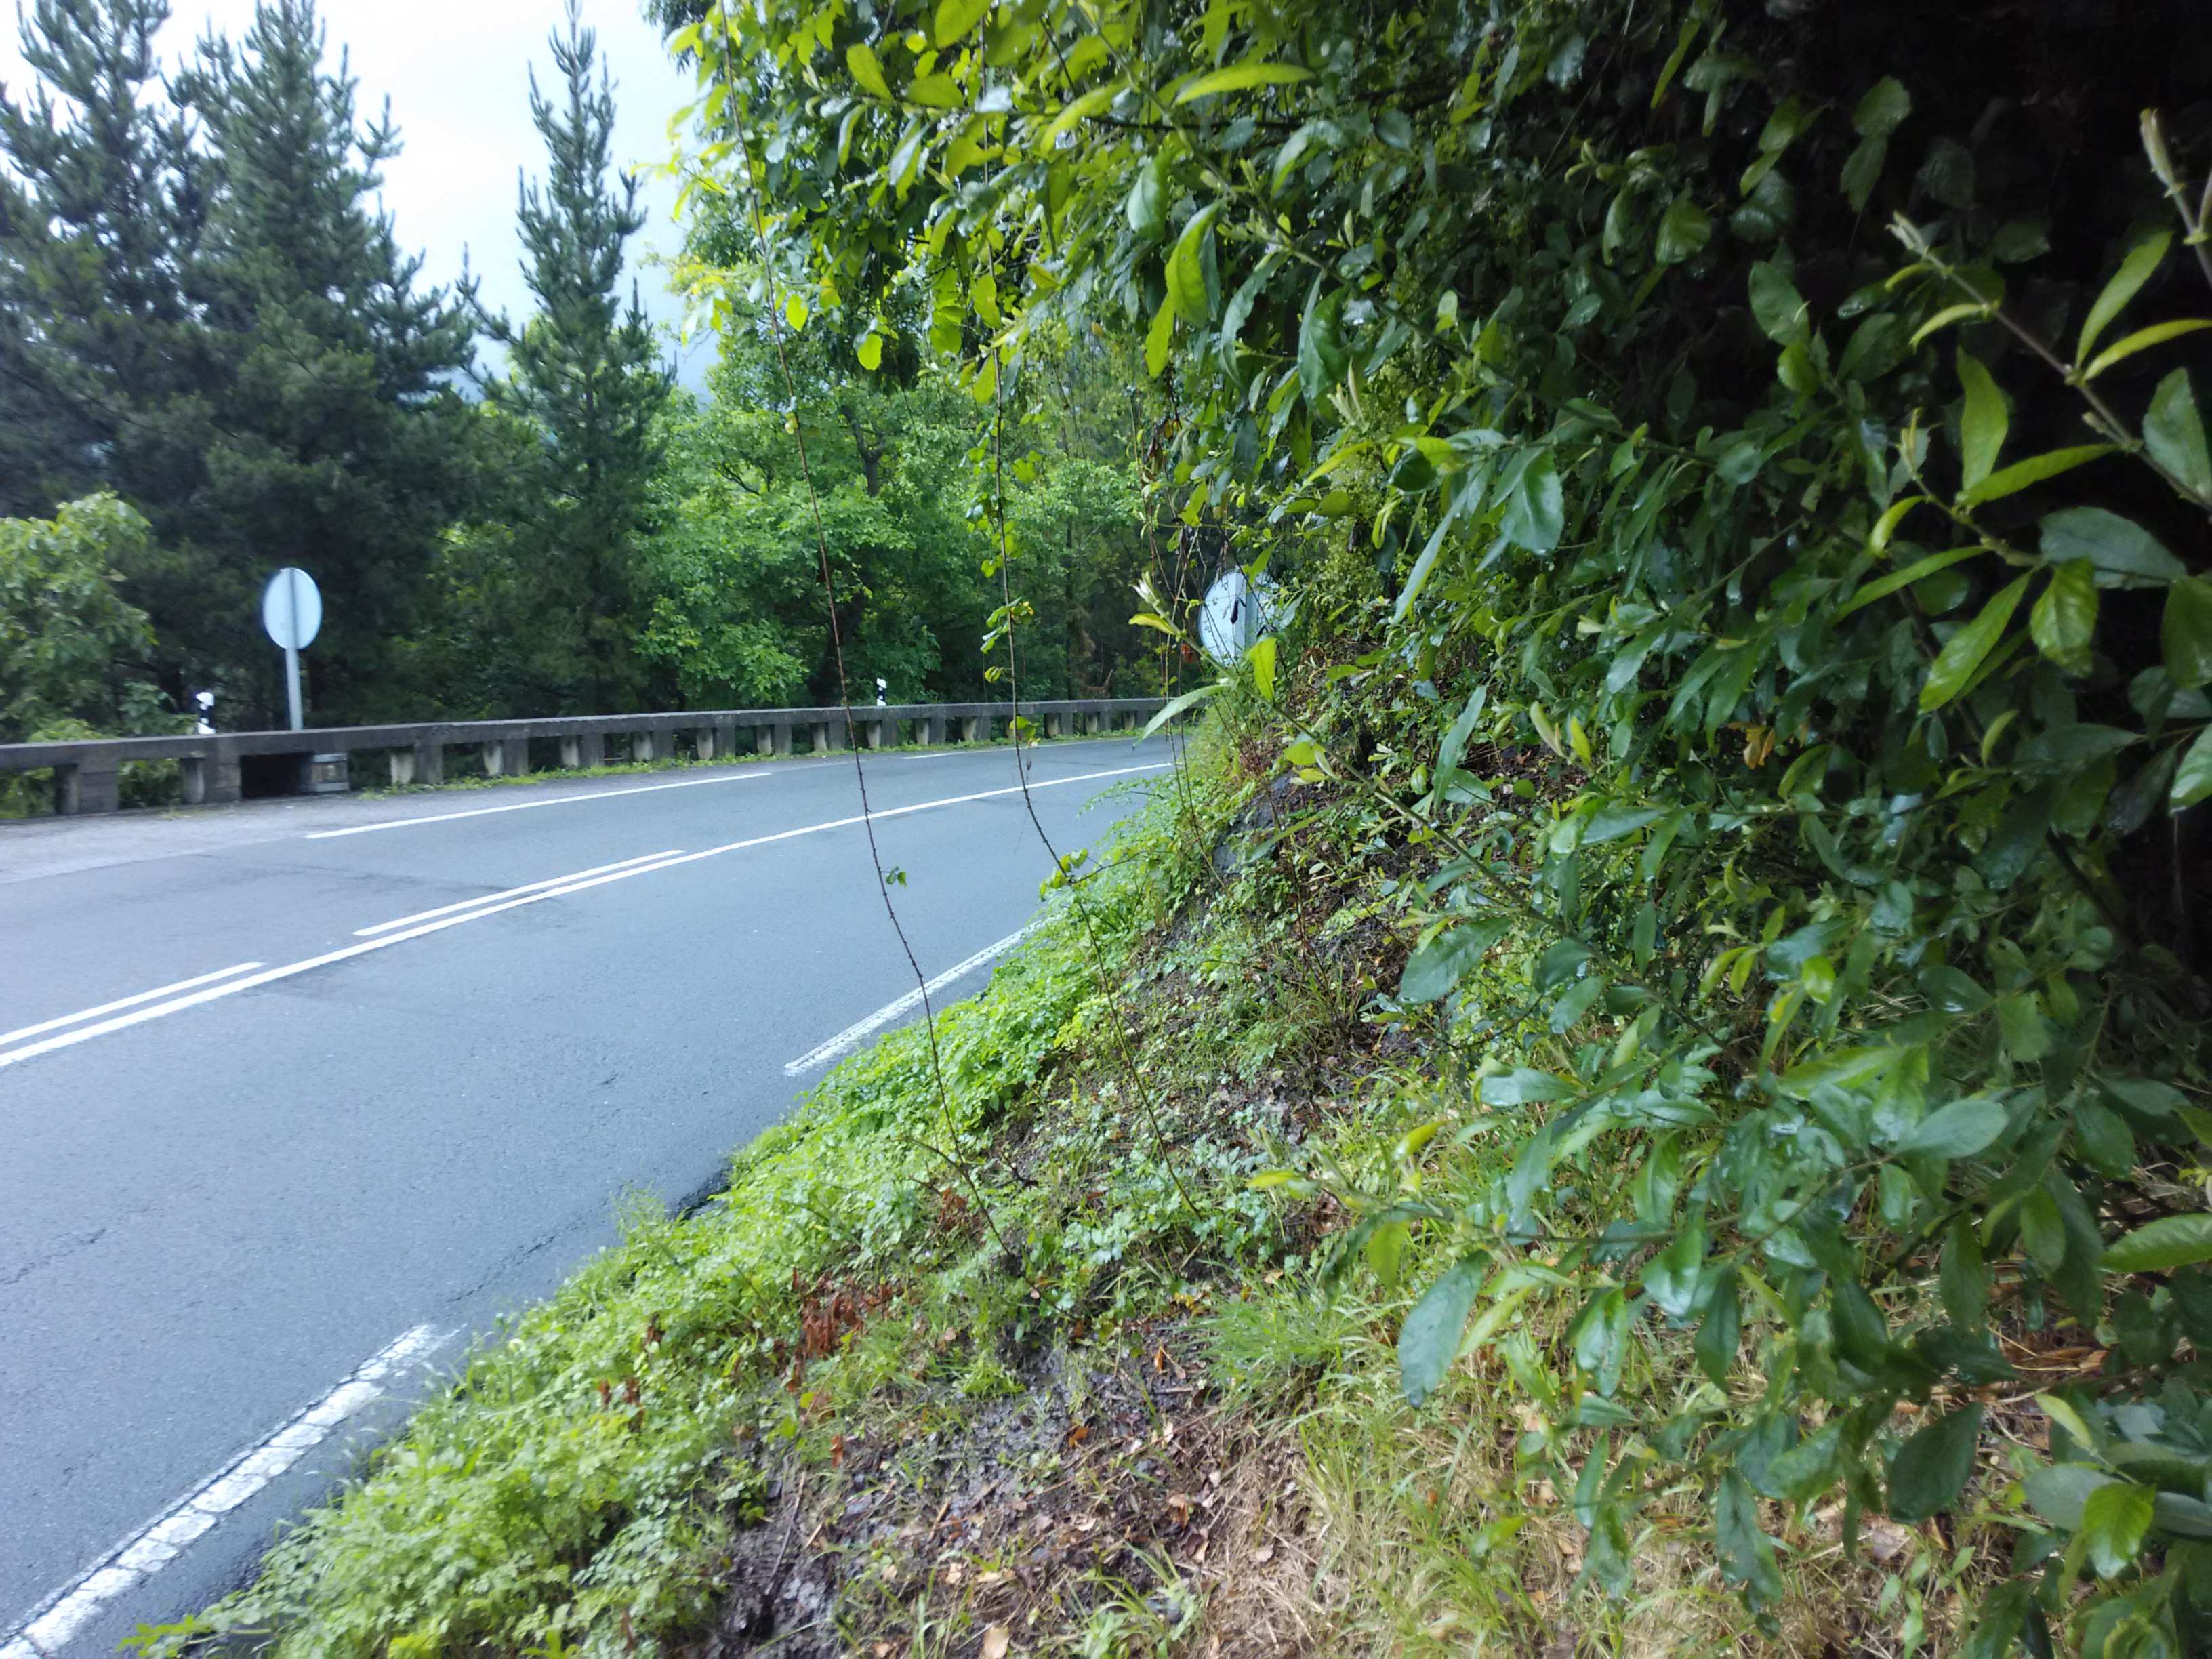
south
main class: Woodland
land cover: Broadleaved woodland
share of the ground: 25 - 50 %
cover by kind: shrubs 40 %, broadleaved forest trees 30 %, consolidated bare surface 30 %
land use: Semi-natural and natural areas not in use
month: June
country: ES
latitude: 43.2830
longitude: -2.3376
